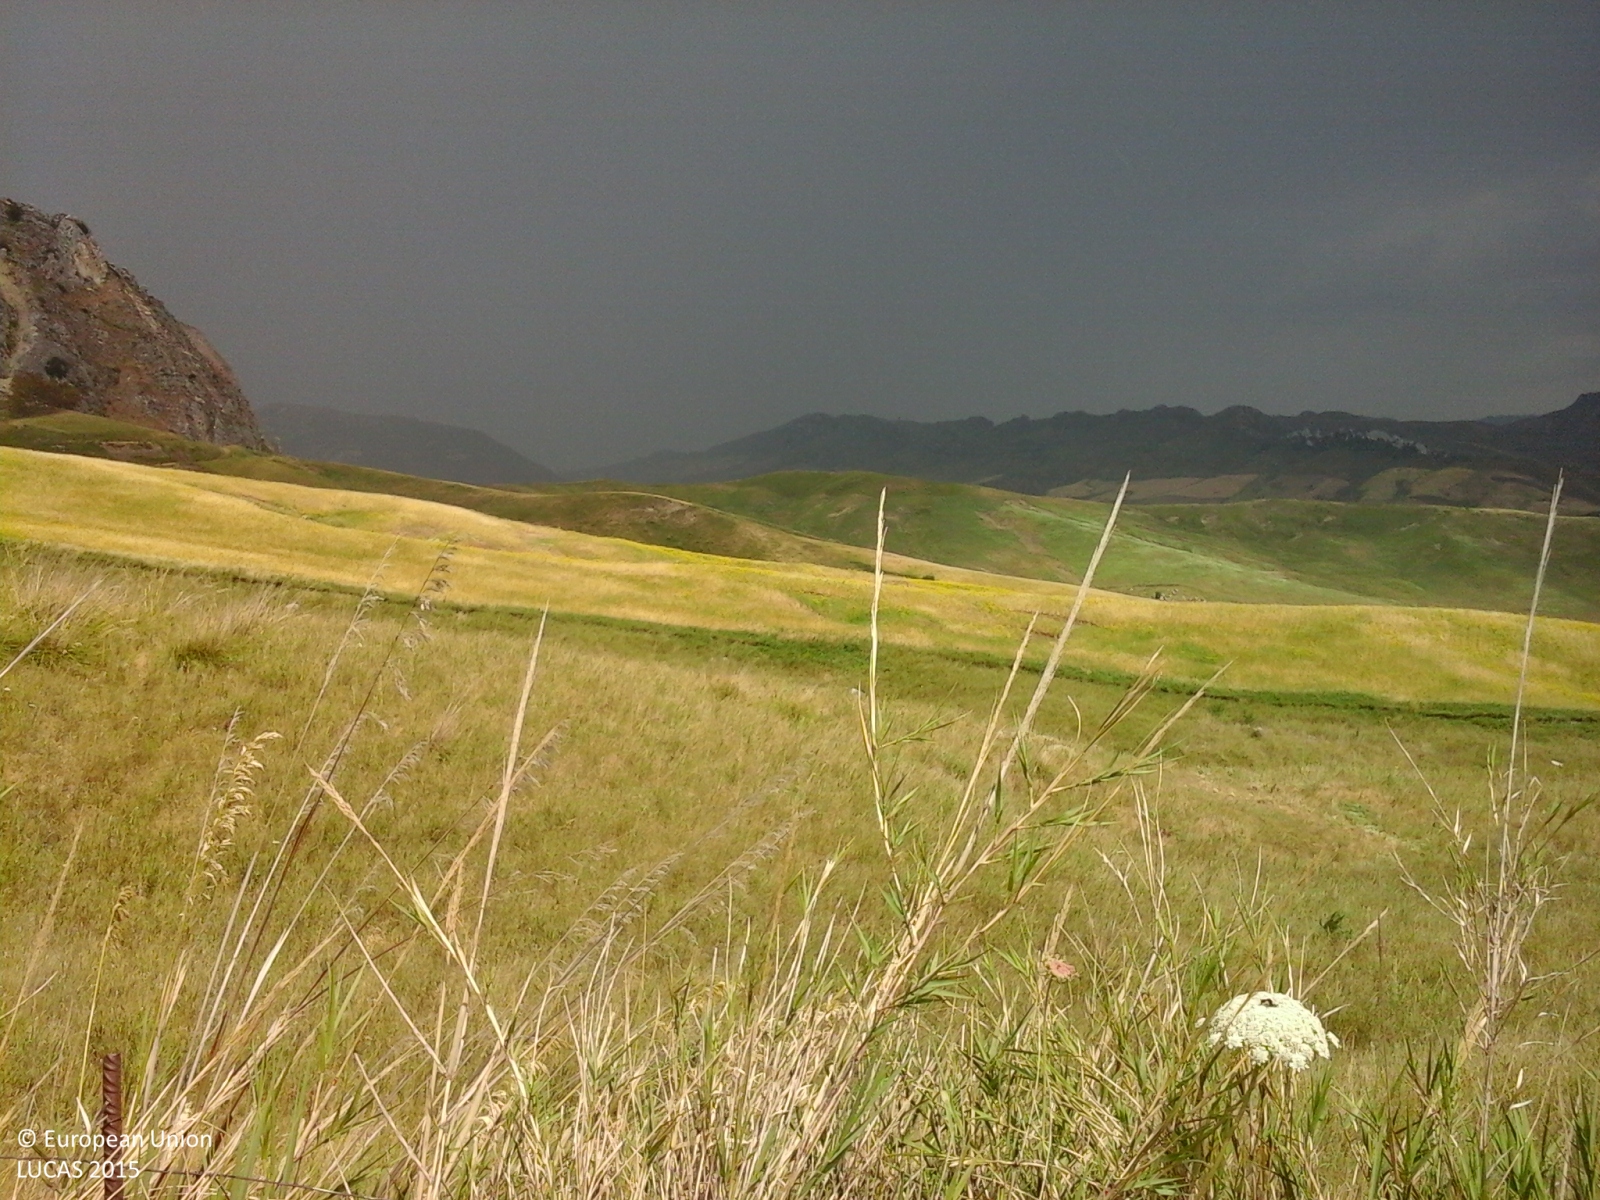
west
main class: Grassland
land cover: Grassland without tree/shrub cover
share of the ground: > 75 %
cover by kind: herbaceous plants 100 %
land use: Semi-natural and natural areas not in use
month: June
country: IT
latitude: 37.5899
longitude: 13.5633
